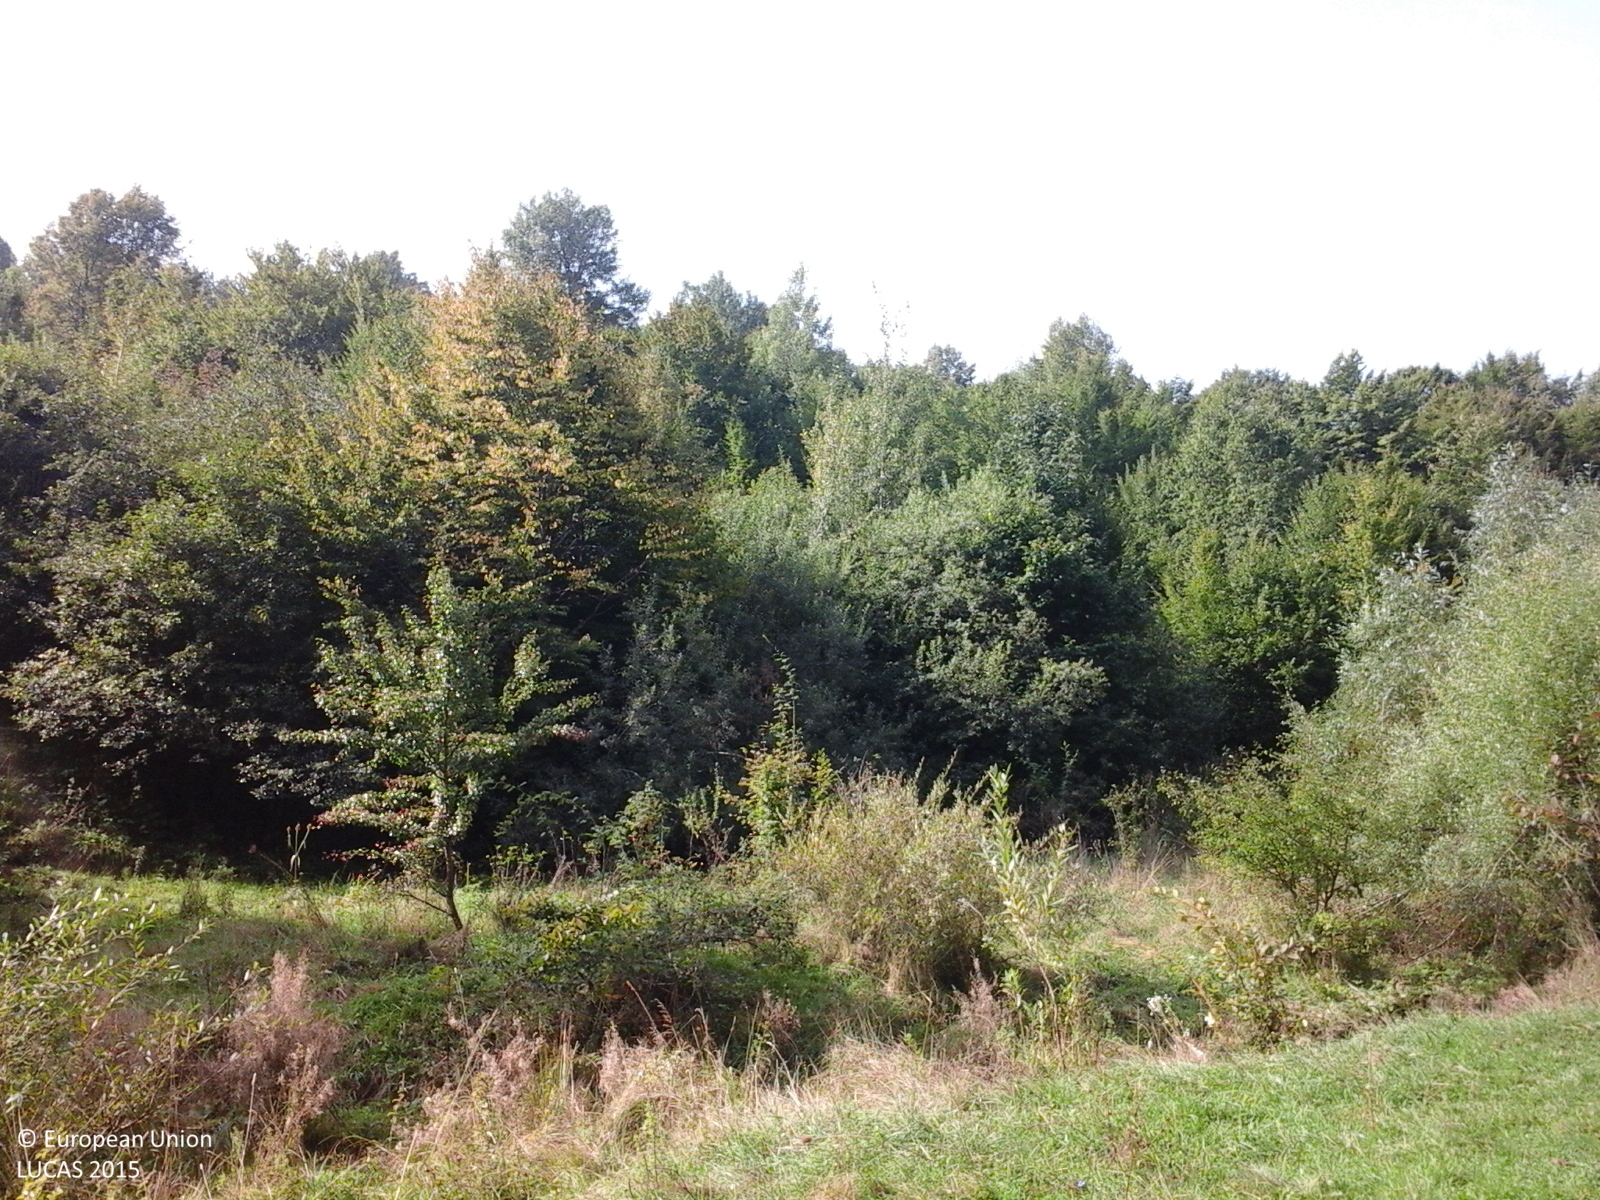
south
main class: Woodland
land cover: Broadleaved woodland
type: mesophytic deciduous forest
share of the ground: > 75 %
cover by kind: broadleaved forest trees 100 %
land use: Forestry
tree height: > 5 m
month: September
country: RO
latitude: 46.8009
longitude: 22.9400
